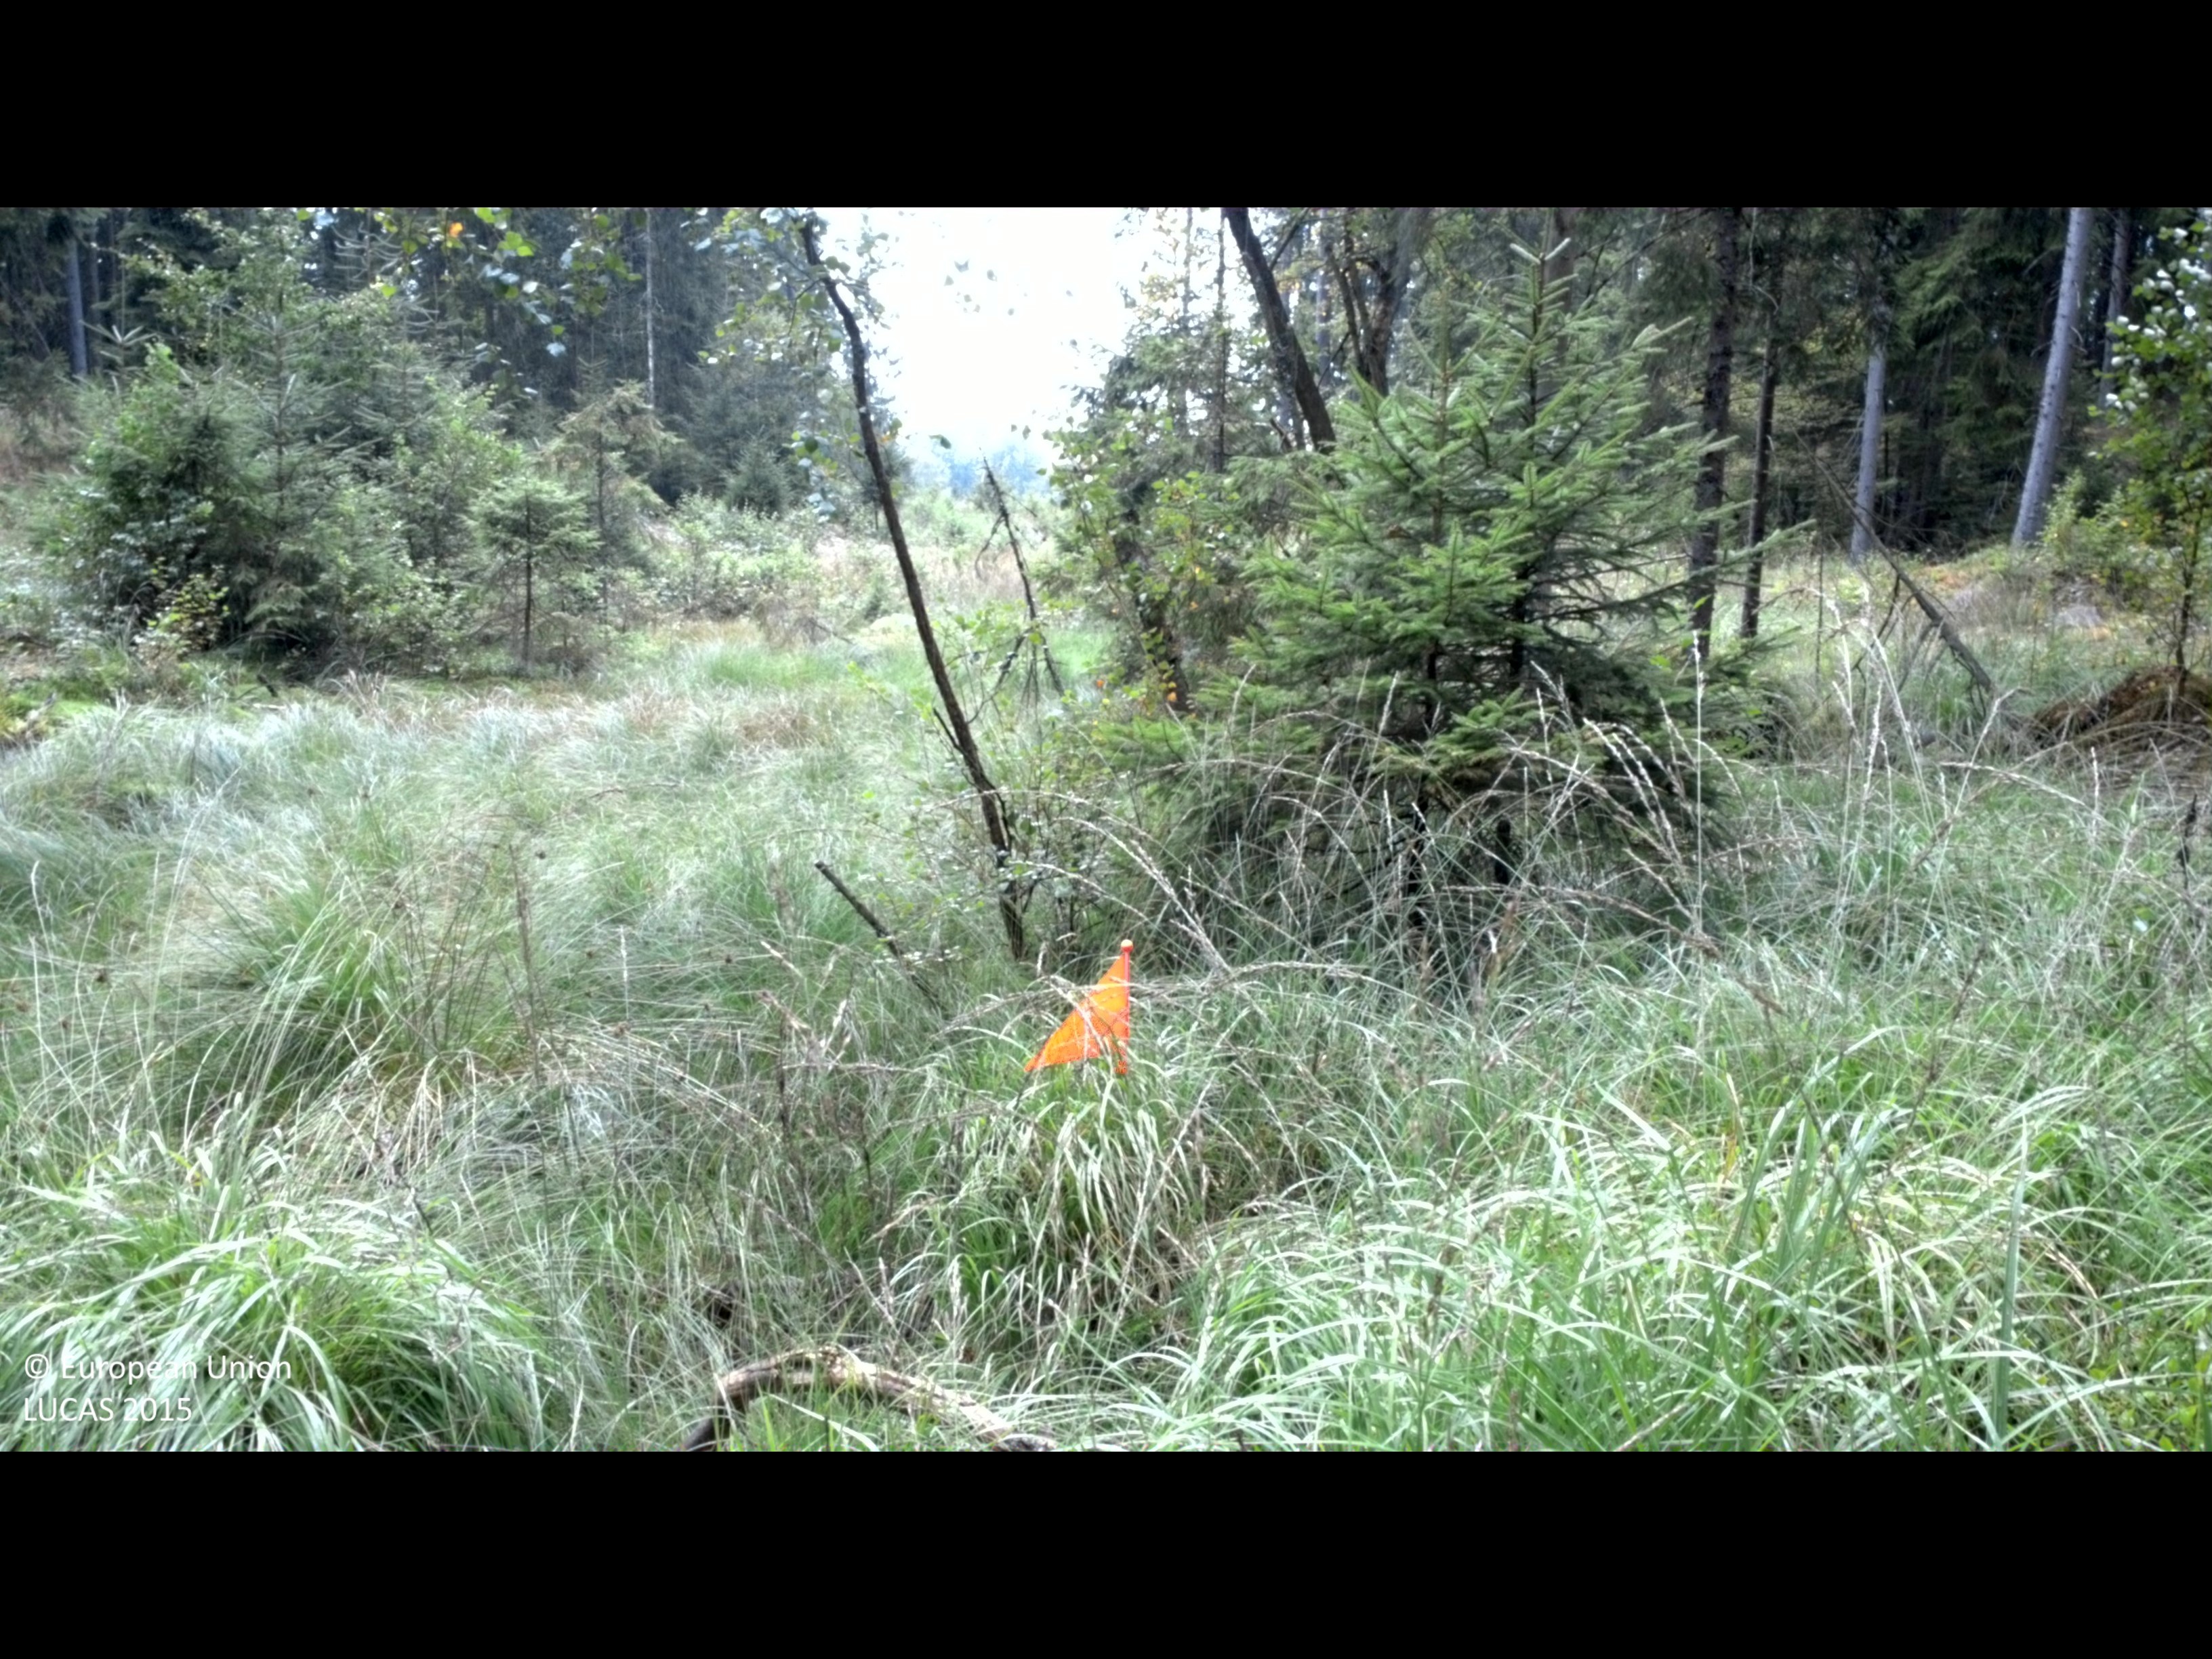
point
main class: Grassland
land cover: Grassland with sparse tree/shrub cover
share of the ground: > 75 %
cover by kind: herbaceous plants 90 %, broadleaved forest trees 5 %, shrubs 5 %
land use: Forestry
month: August
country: SE
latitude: 56.8490
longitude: 13.2266
